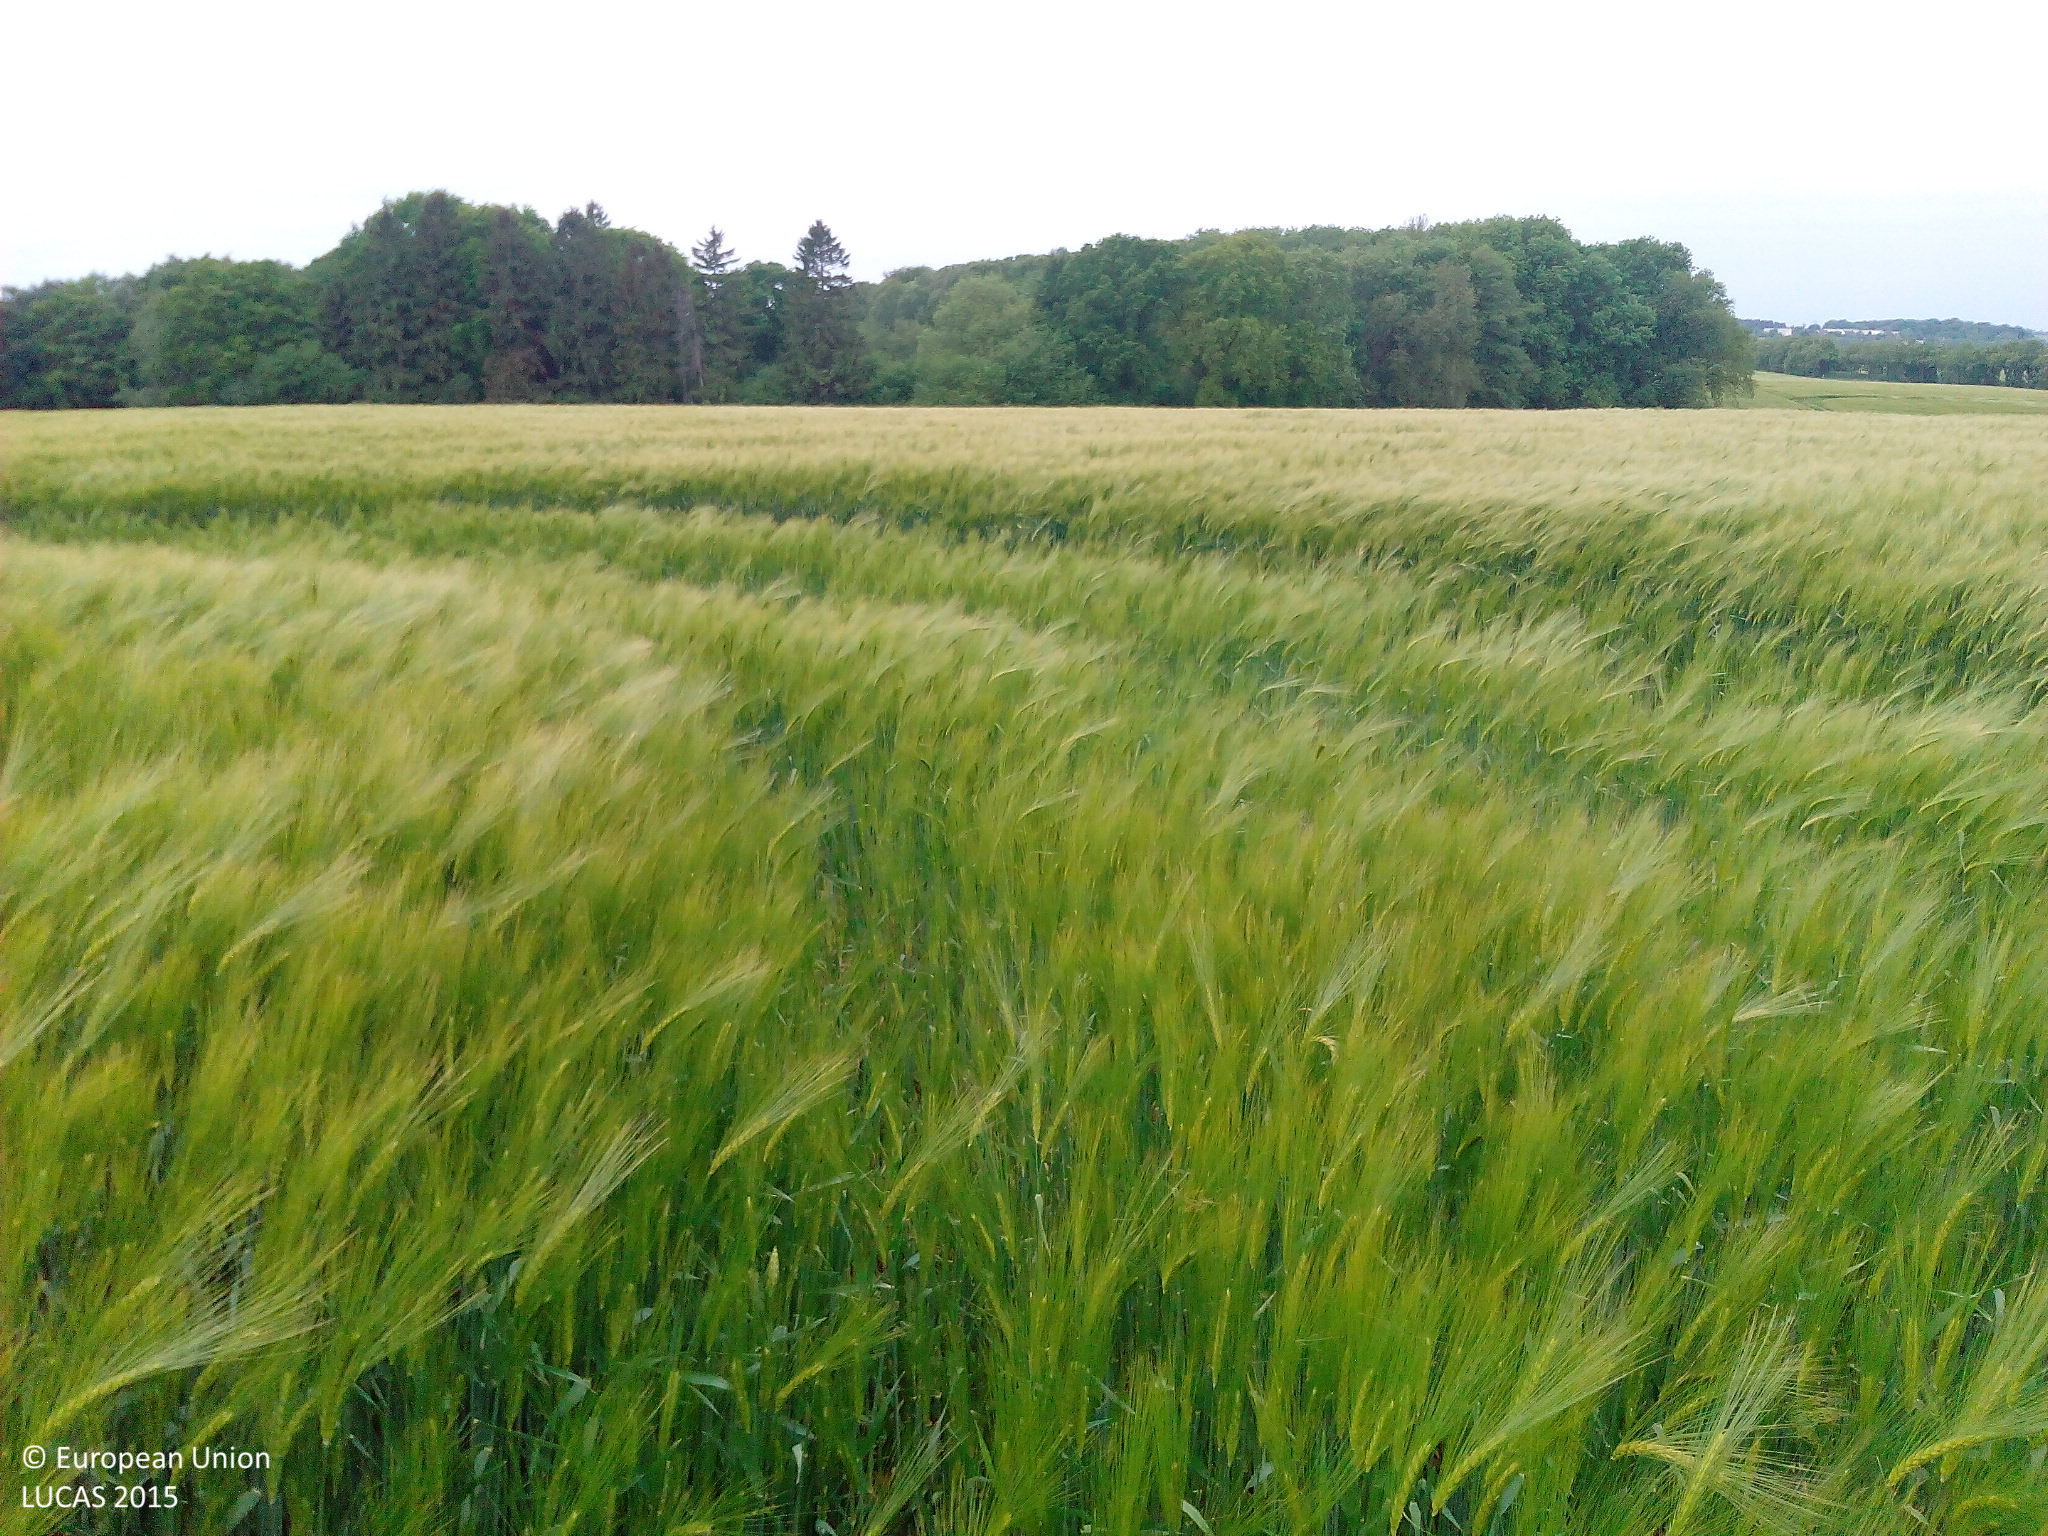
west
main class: Cropland
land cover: Barley
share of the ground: > 75 %
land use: Agriculture (excluding fallow land and kitchen gardens)
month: June
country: DE
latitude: 54.2923
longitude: 13.3024
